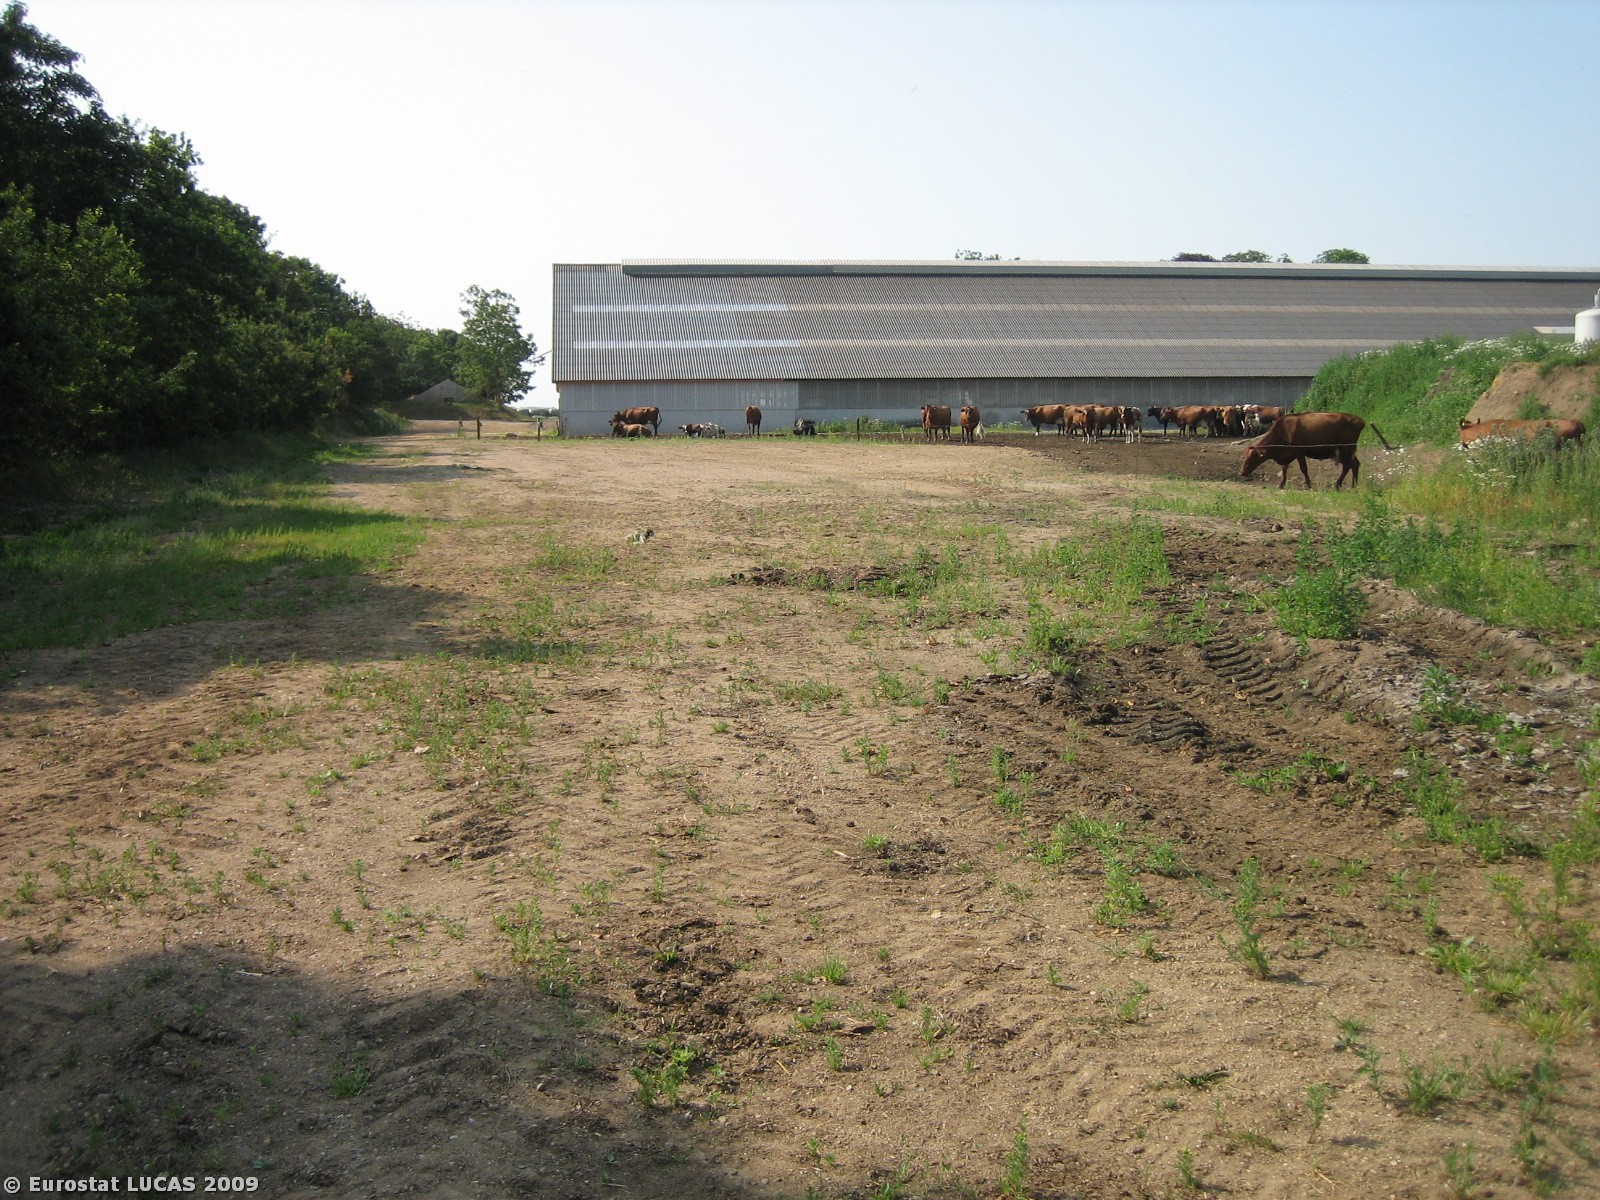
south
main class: Grassland
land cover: Grassland without tree/shrub cover
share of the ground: > 75 %
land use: Agriculture (excluding fallow land and kitchen gardens)
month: July
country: DK
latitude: 55.5187
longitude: 9.0031
